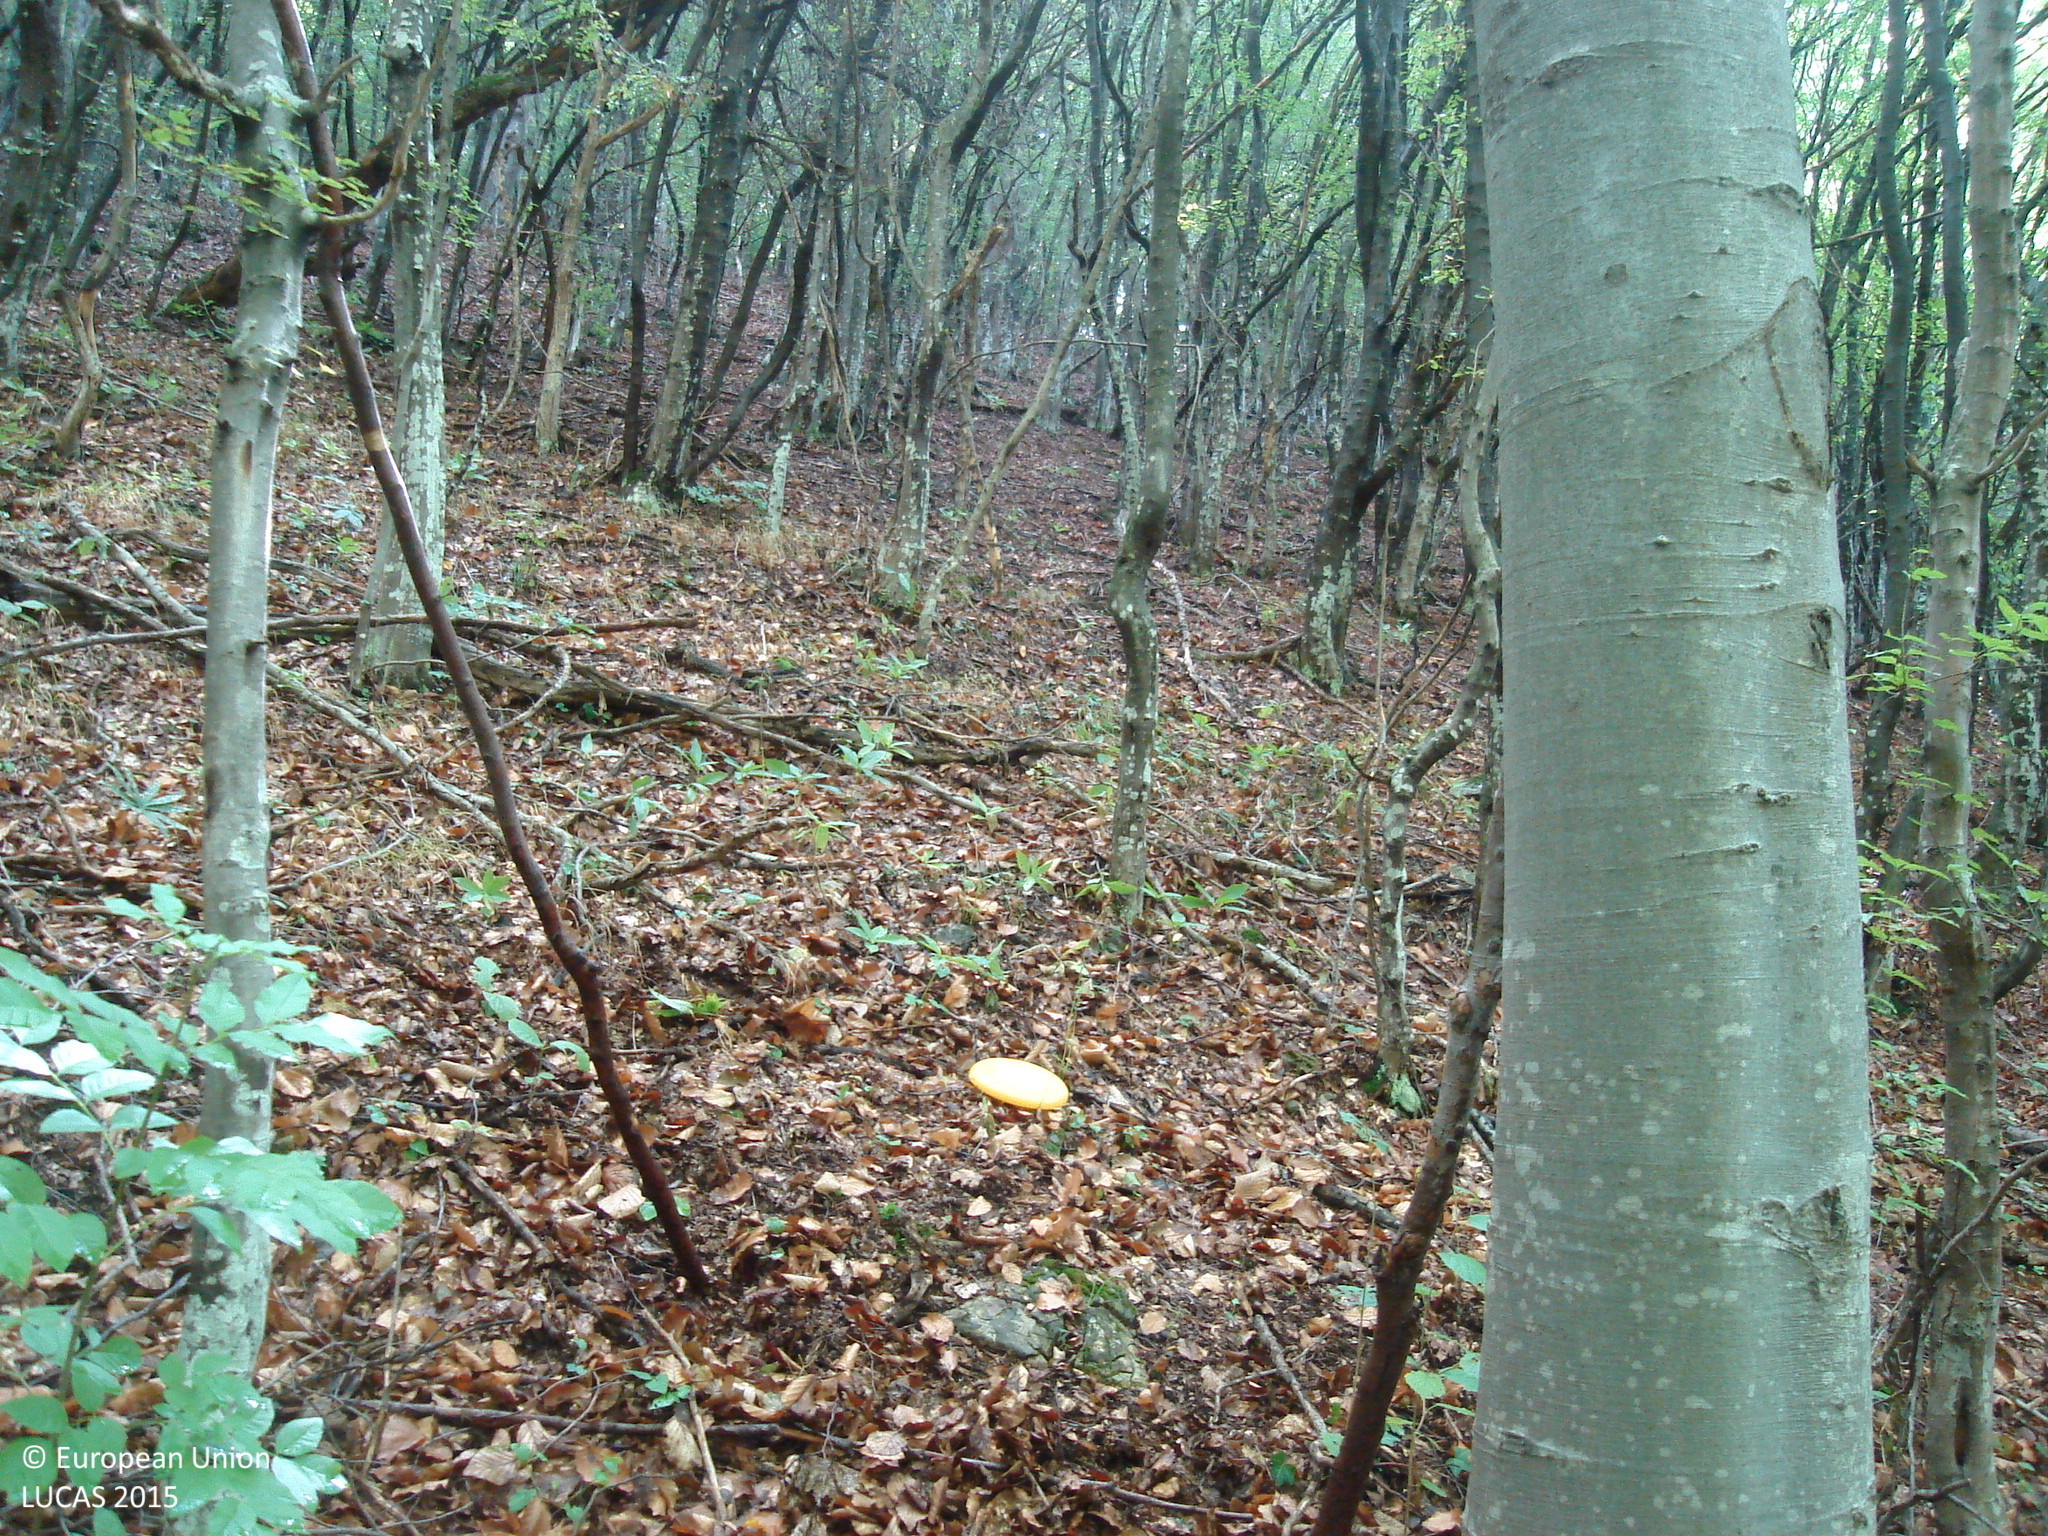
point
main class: Woodland
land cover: Broadleaved woodland
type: beech forest
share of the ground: 50 - 75 %
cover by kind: broadleaved forest trees 70 %, consolidated bare surface 20 %, herbaceous plants 5 %, lichens and mosses 5 %
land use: Forestry
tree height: > 5 m
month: October
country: BG
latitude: 43.0201
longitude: 23.4014
